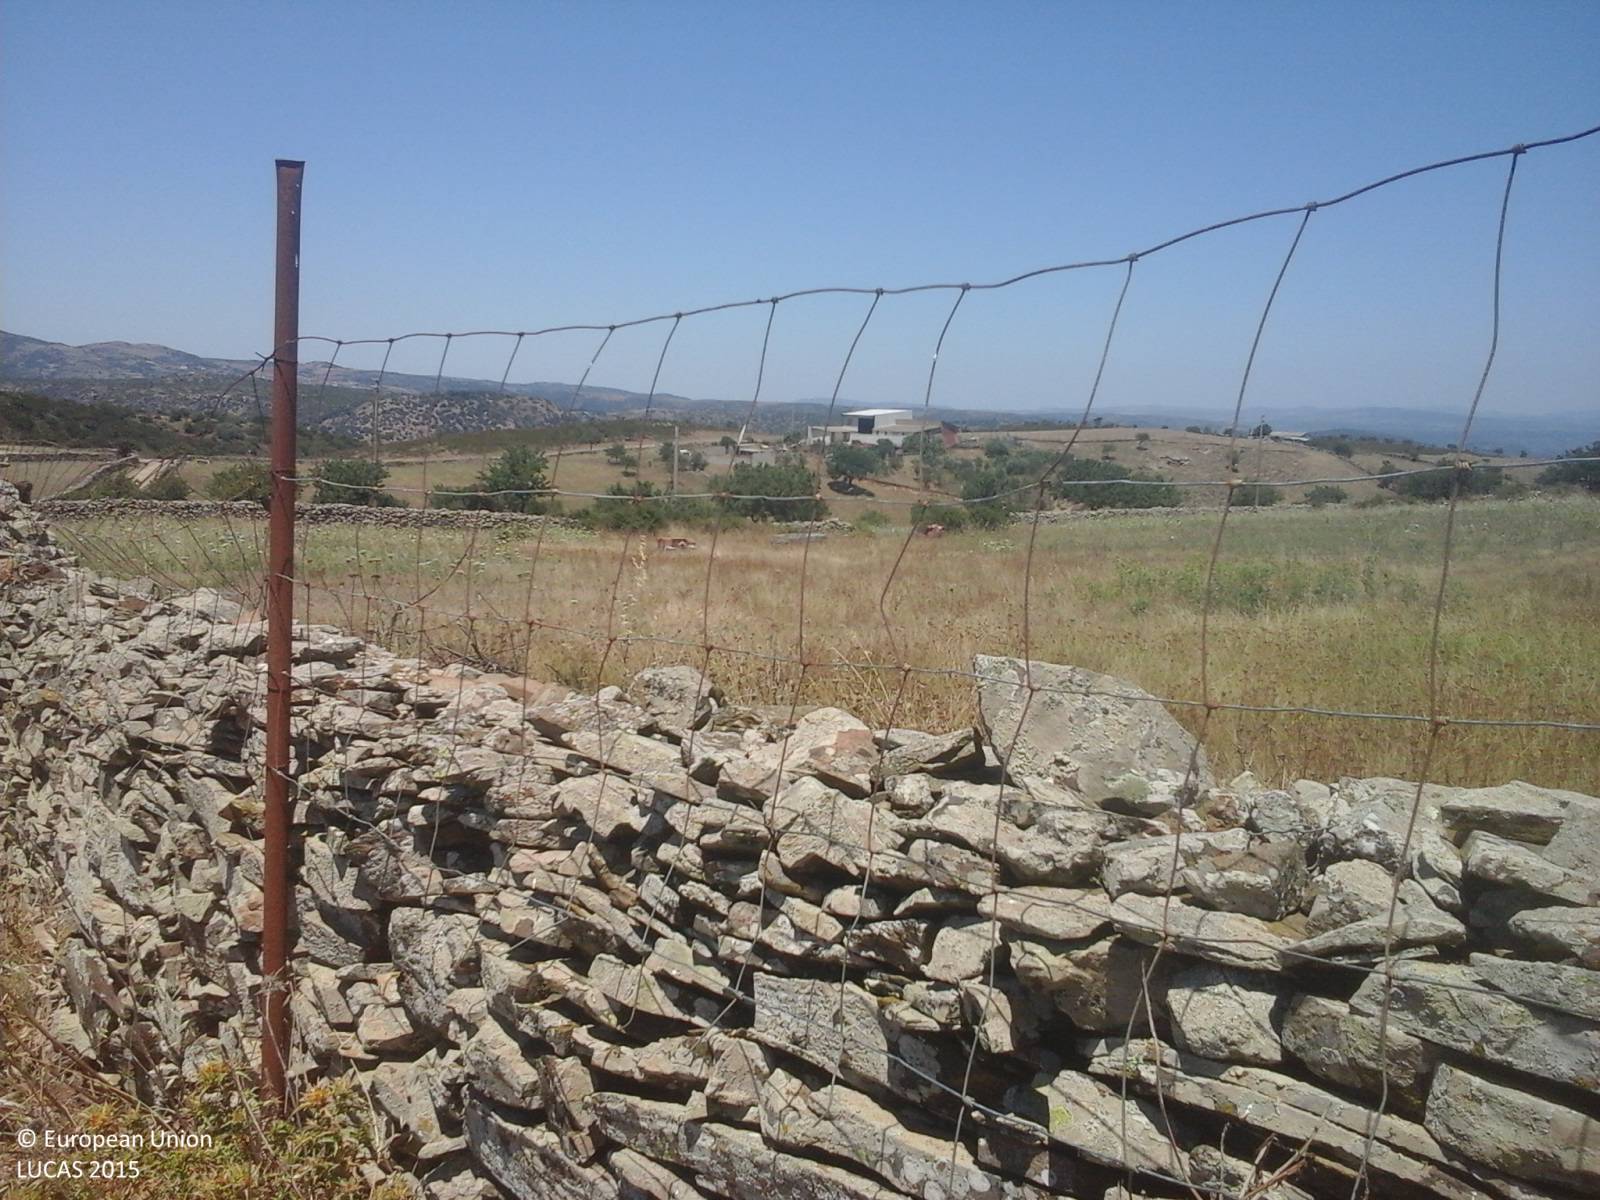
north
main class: Grassland
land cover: Grassland without tree/shrub cover
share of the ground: > 75 %
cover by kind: herbaceous plants 65 %, unconsolidated bare surface 30 %, shrubs 5 %
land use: Agriculture (excluding fallow land and kitchen gardens)
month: July
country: IT
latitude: 39.4865
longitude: 9.3643
